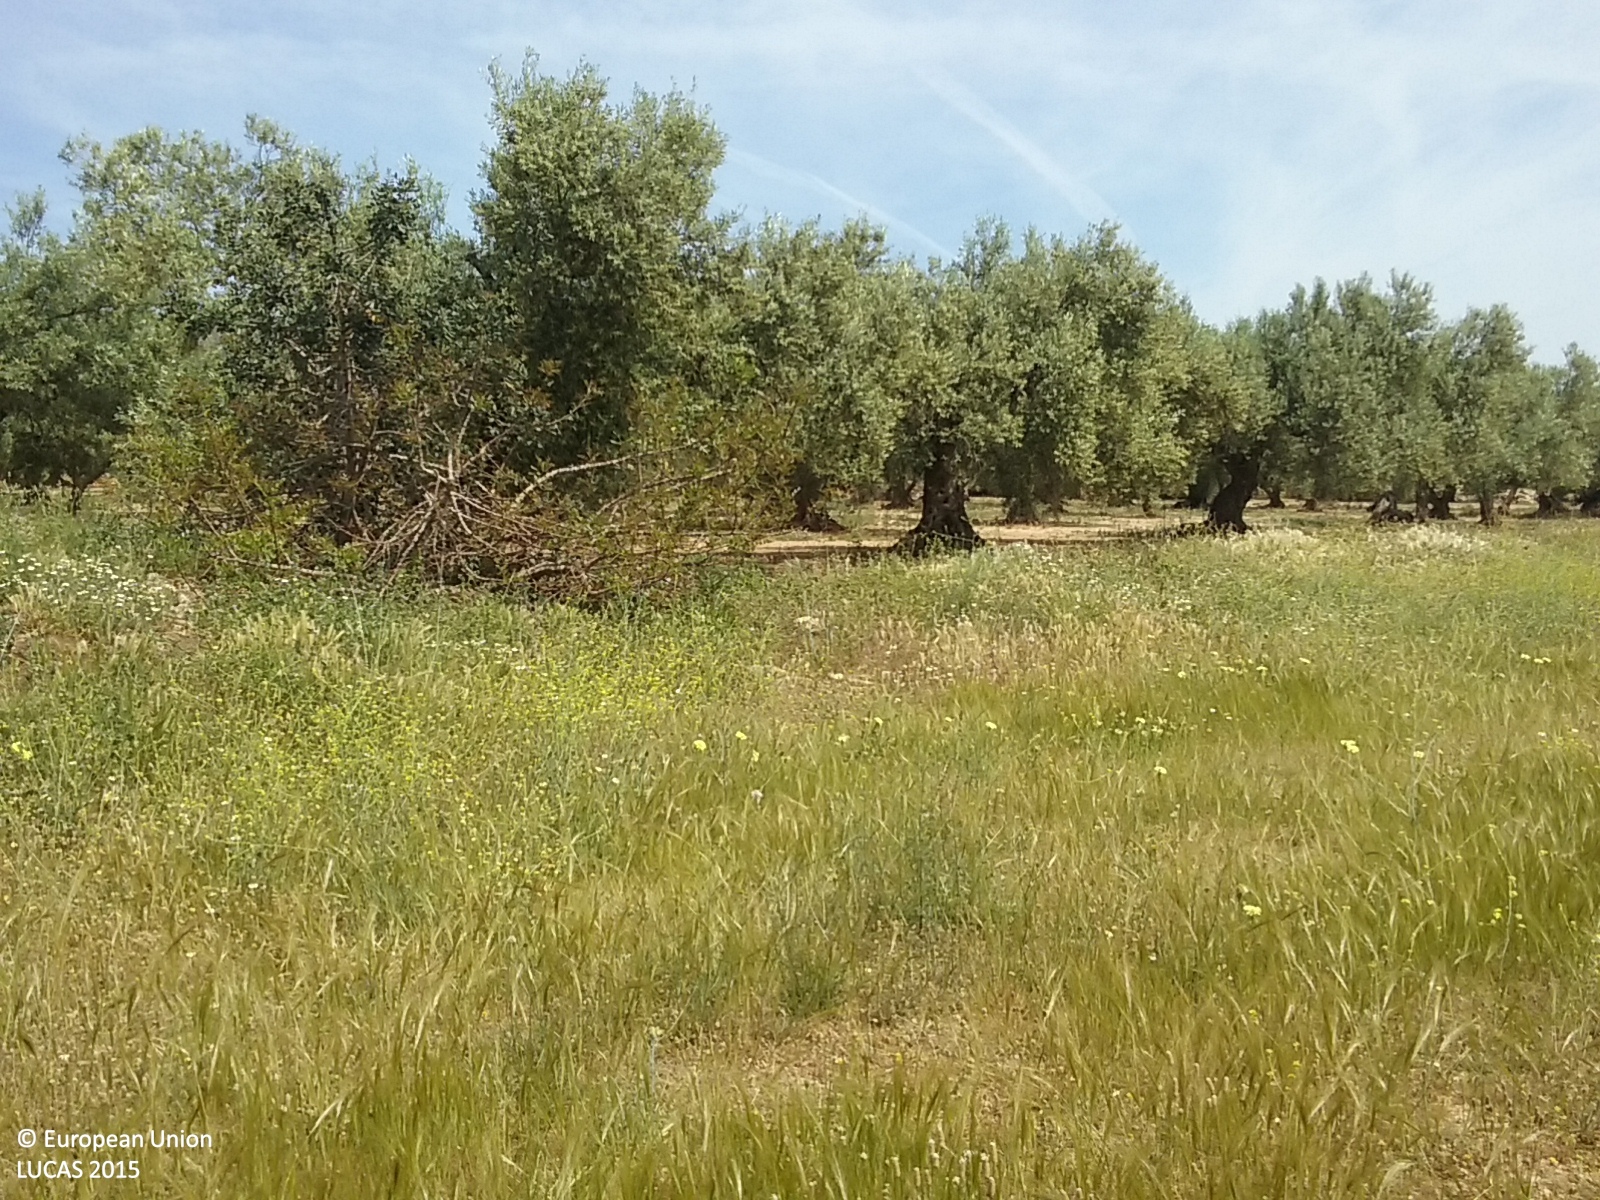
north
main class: Grassland
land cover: Grassland without tree/shrub cover
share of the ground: > 75 %
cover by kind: herbaceous plants 95 %, consolidated bare surface 5 %
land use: Sport
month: May
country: ES
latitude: 40.6423
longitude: 0.3099
